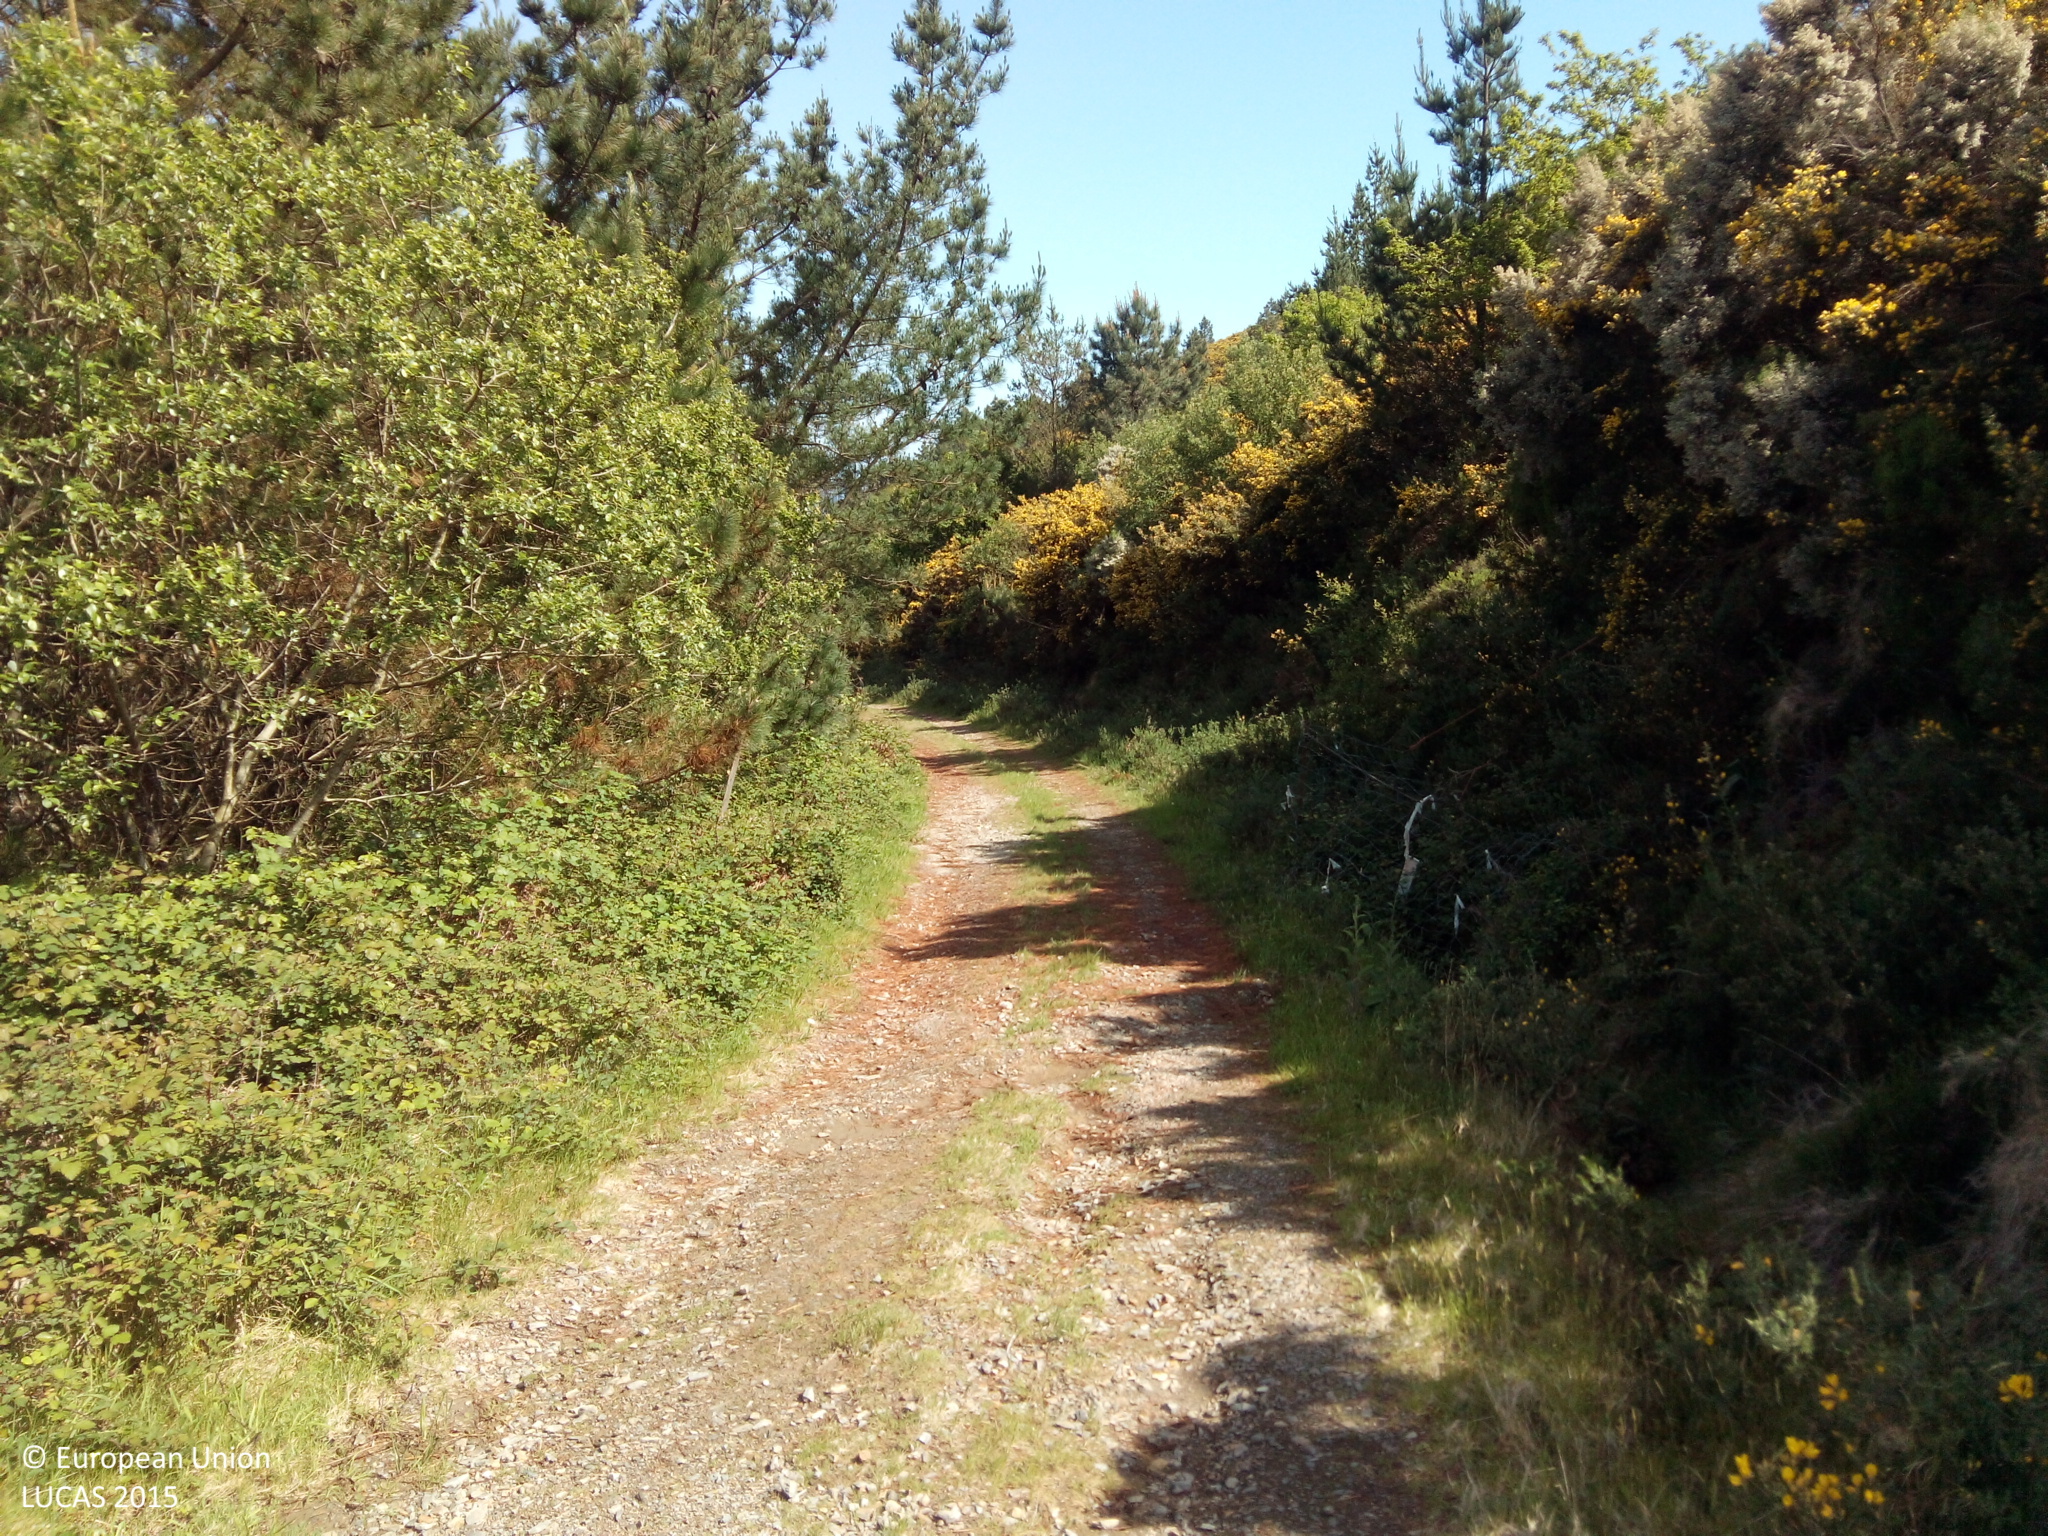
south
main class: Woodland
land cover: Pine dominated coniferous woodland
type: hemiboreal forest and nemoral coniferous forest and mixed broadleaved-coniferous forest
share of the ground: > 75 %
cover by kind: coniferous forest trees 75 %, shrubs 25 %
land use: Forestry
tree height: > 5 m
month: May
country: ES
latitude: 42.8256
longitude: -9.0434
